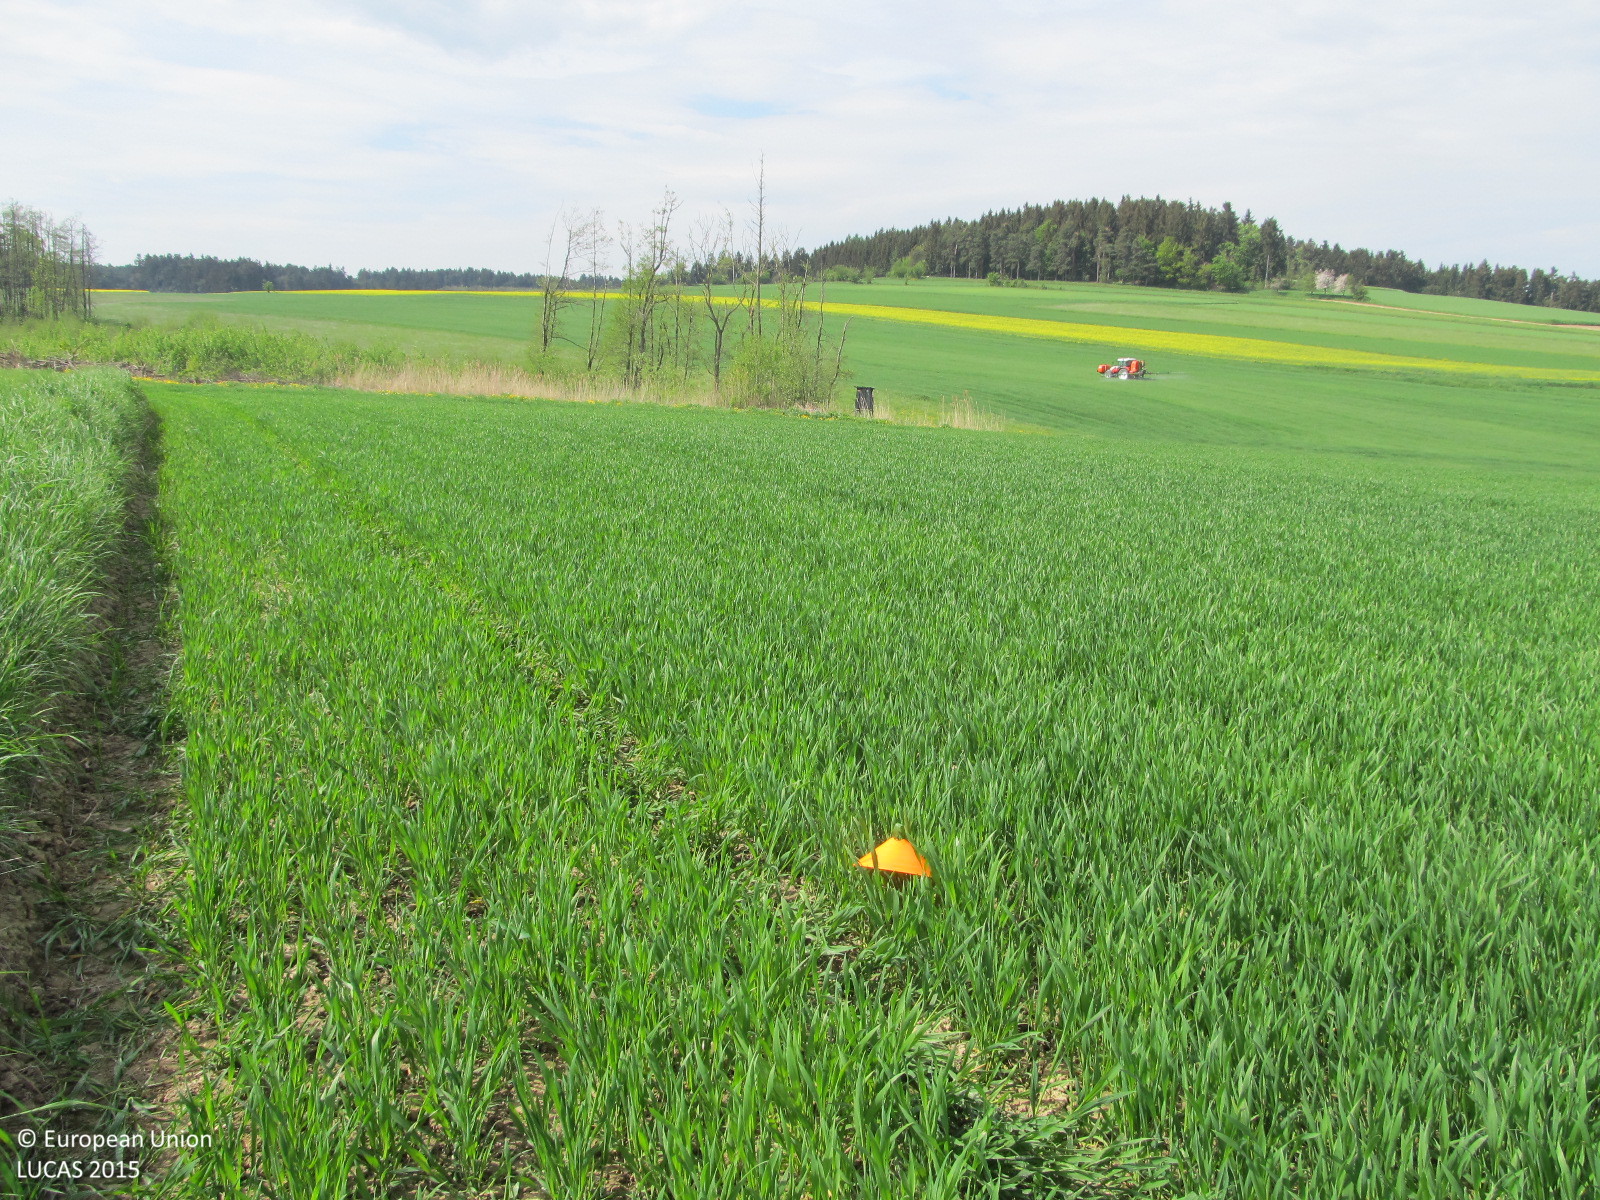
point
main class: Cropland
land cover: Common wheat
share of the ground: 50 - 75 %
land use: Agriculture (excluding fallow land and kitchen gardens)
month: May
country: AT
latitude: 48.5059
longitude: 15.4031
